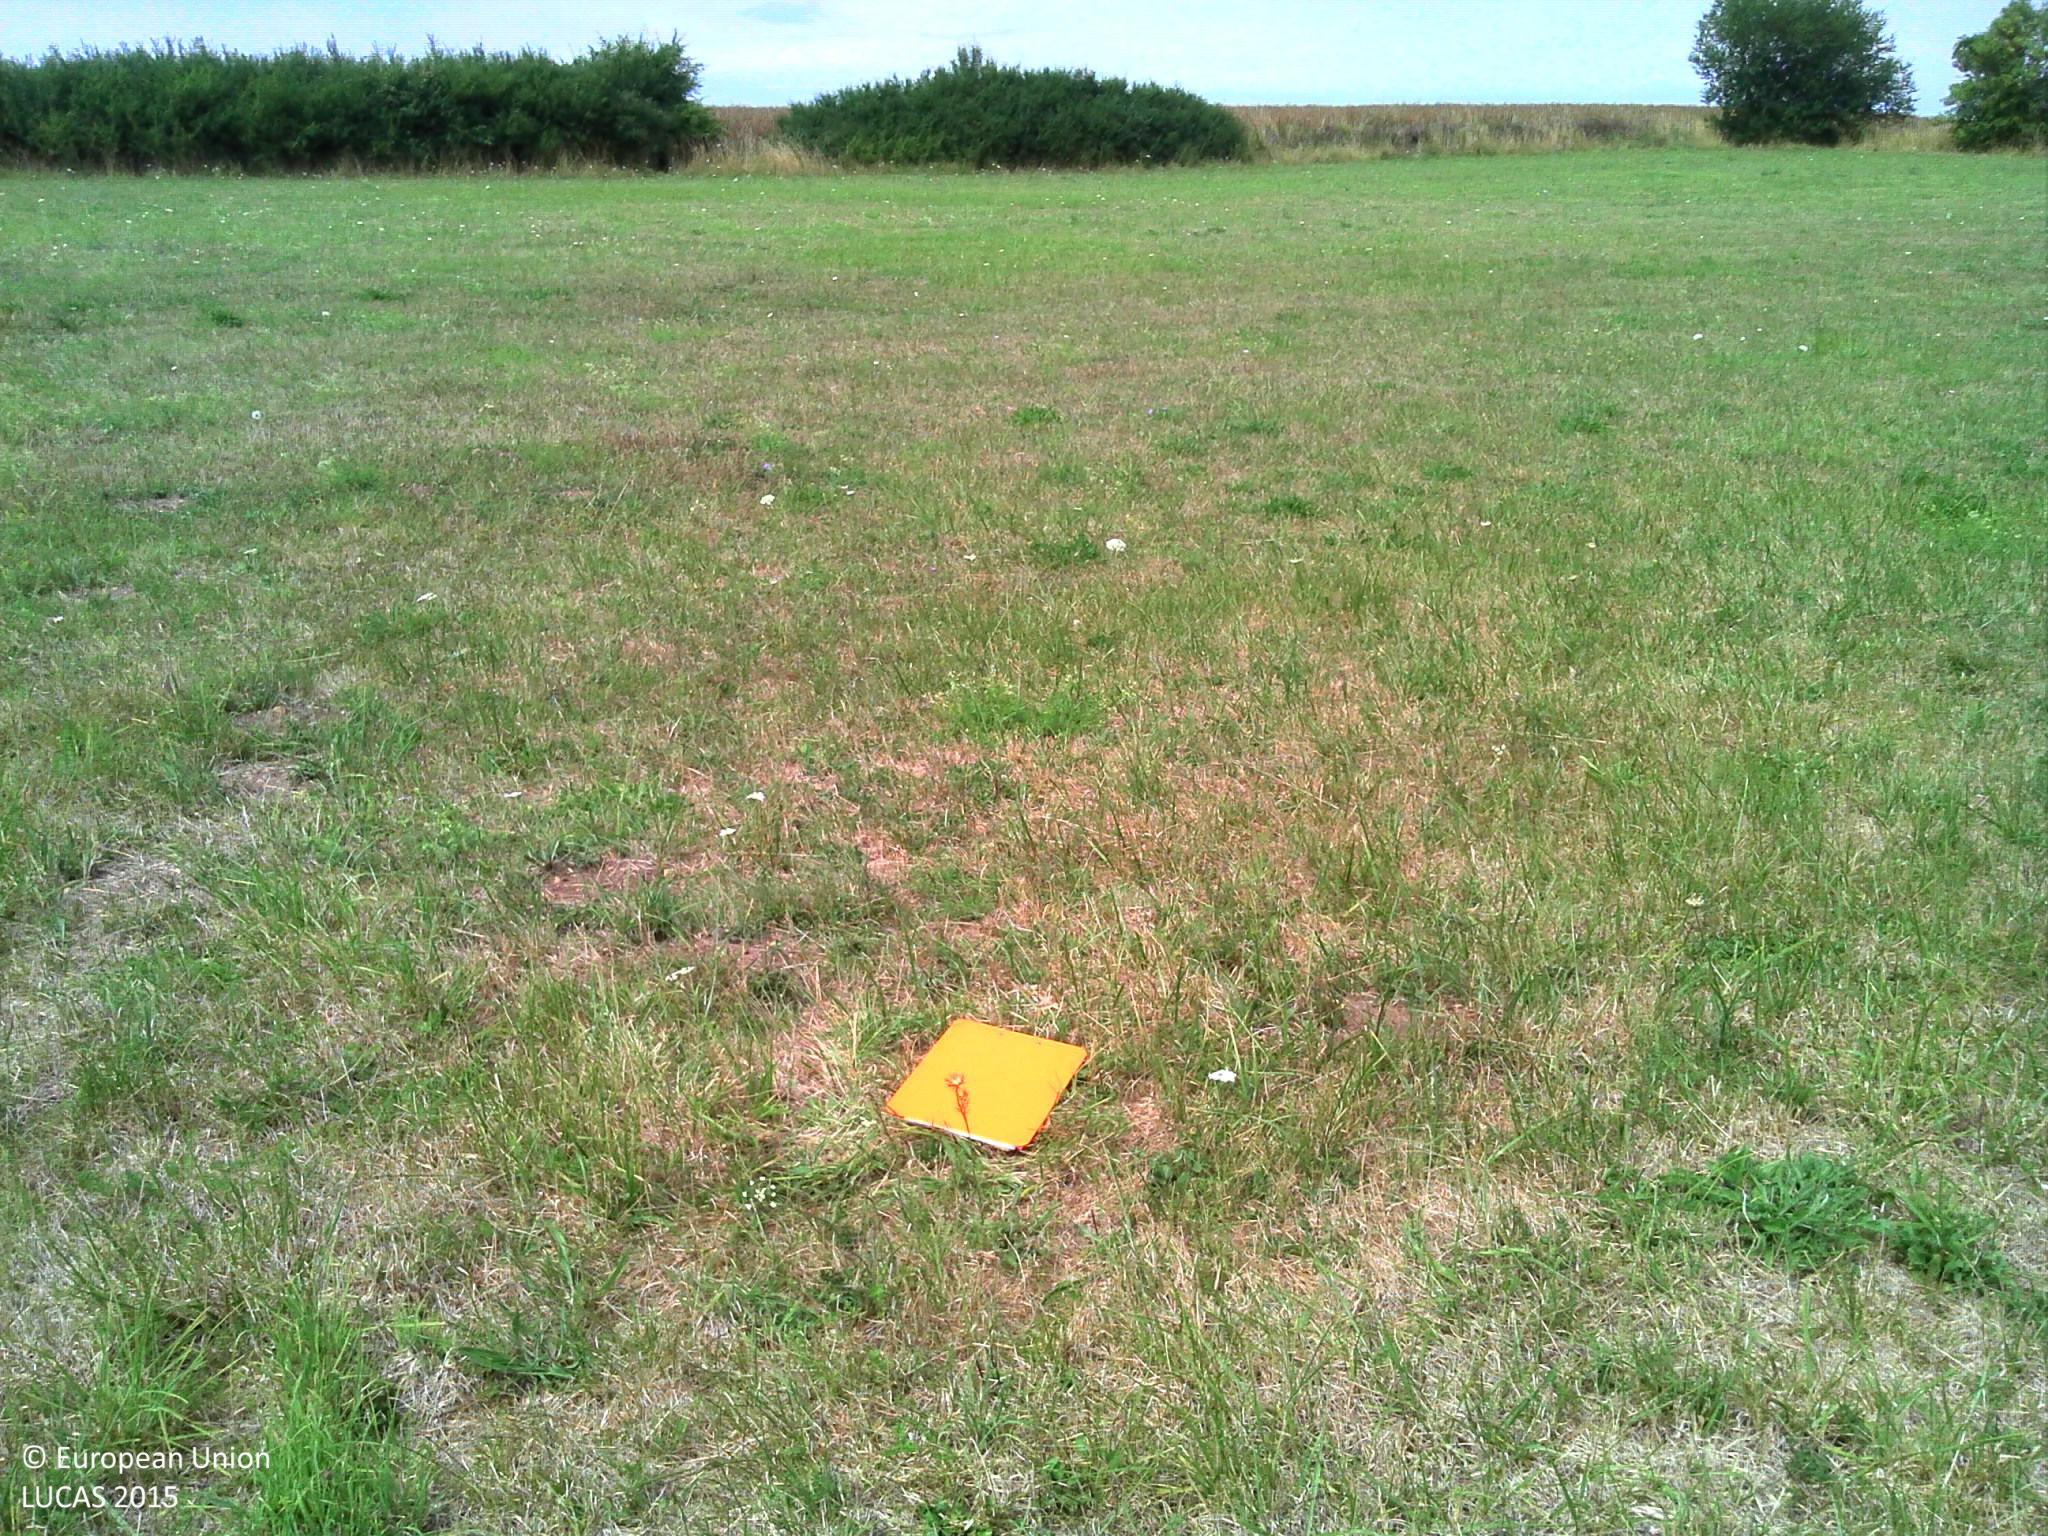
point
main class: Grassland
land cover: Grassland without tree/shrub cover
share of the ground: > 75 %
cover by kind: herbaceous plants 100 %
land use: Agriculture (excluding fallow land and kitchen gardens)
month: July
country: FR
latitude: 49.0726
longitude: -0.2037
